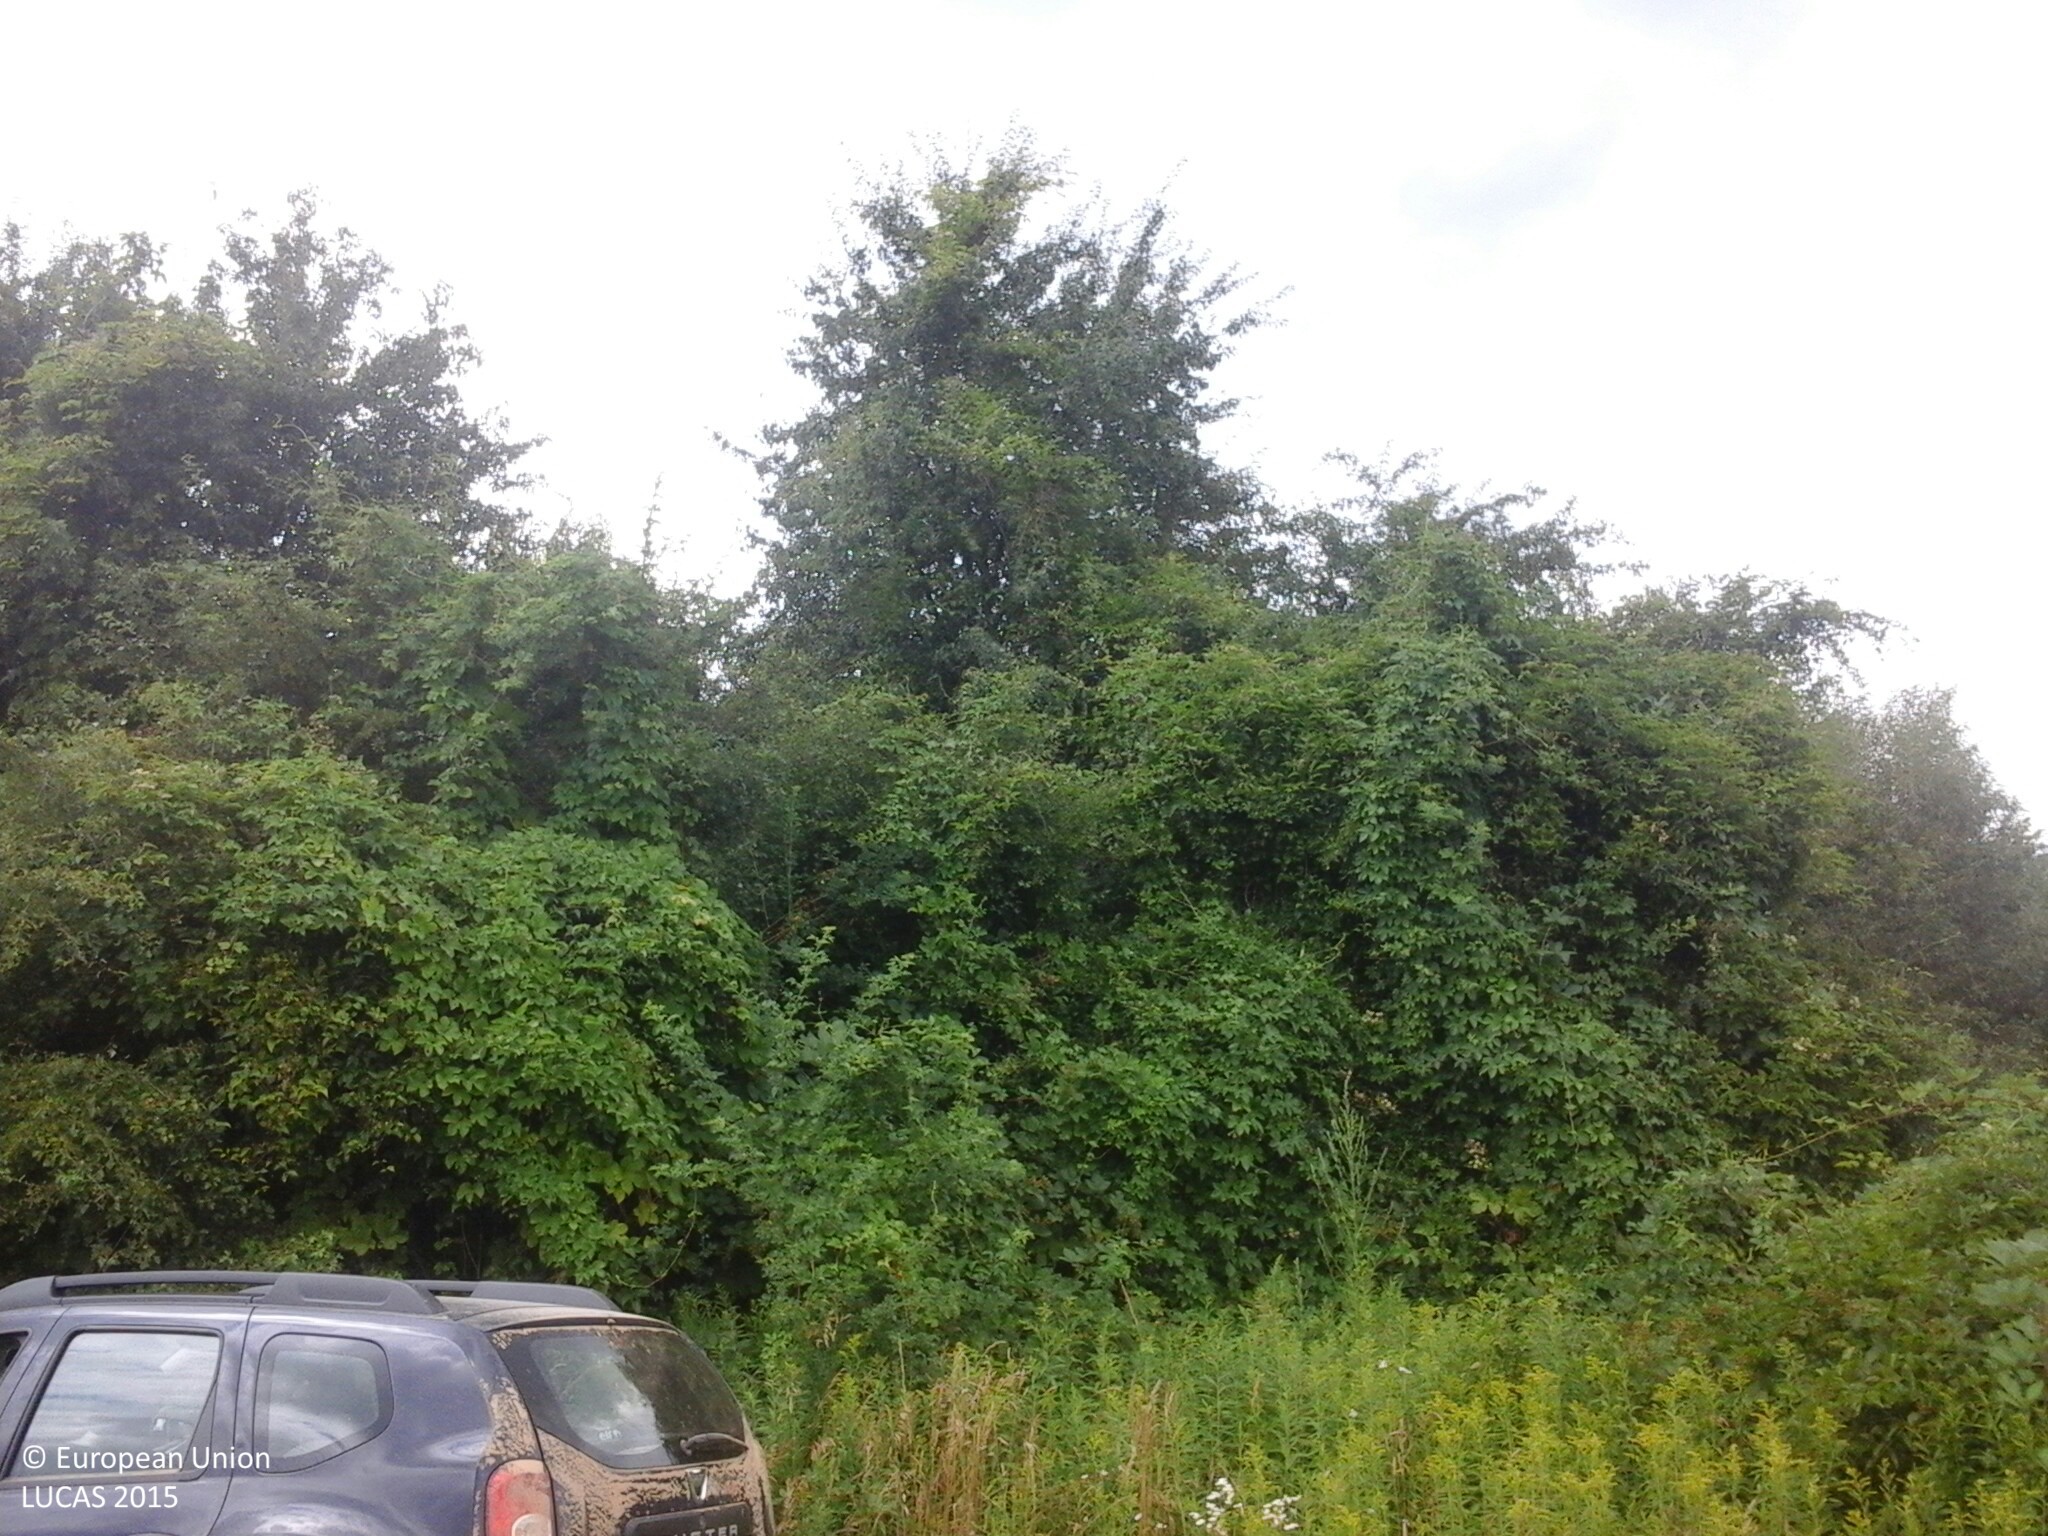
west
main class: Grassland
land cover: Spontaneously vegetated surfaces
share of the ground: > 75 %
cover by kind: herbaceous plants 100 %
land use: Semi-natural and natural areas not in use
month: July
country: HU
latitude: 47.3007
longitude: 17.9849
